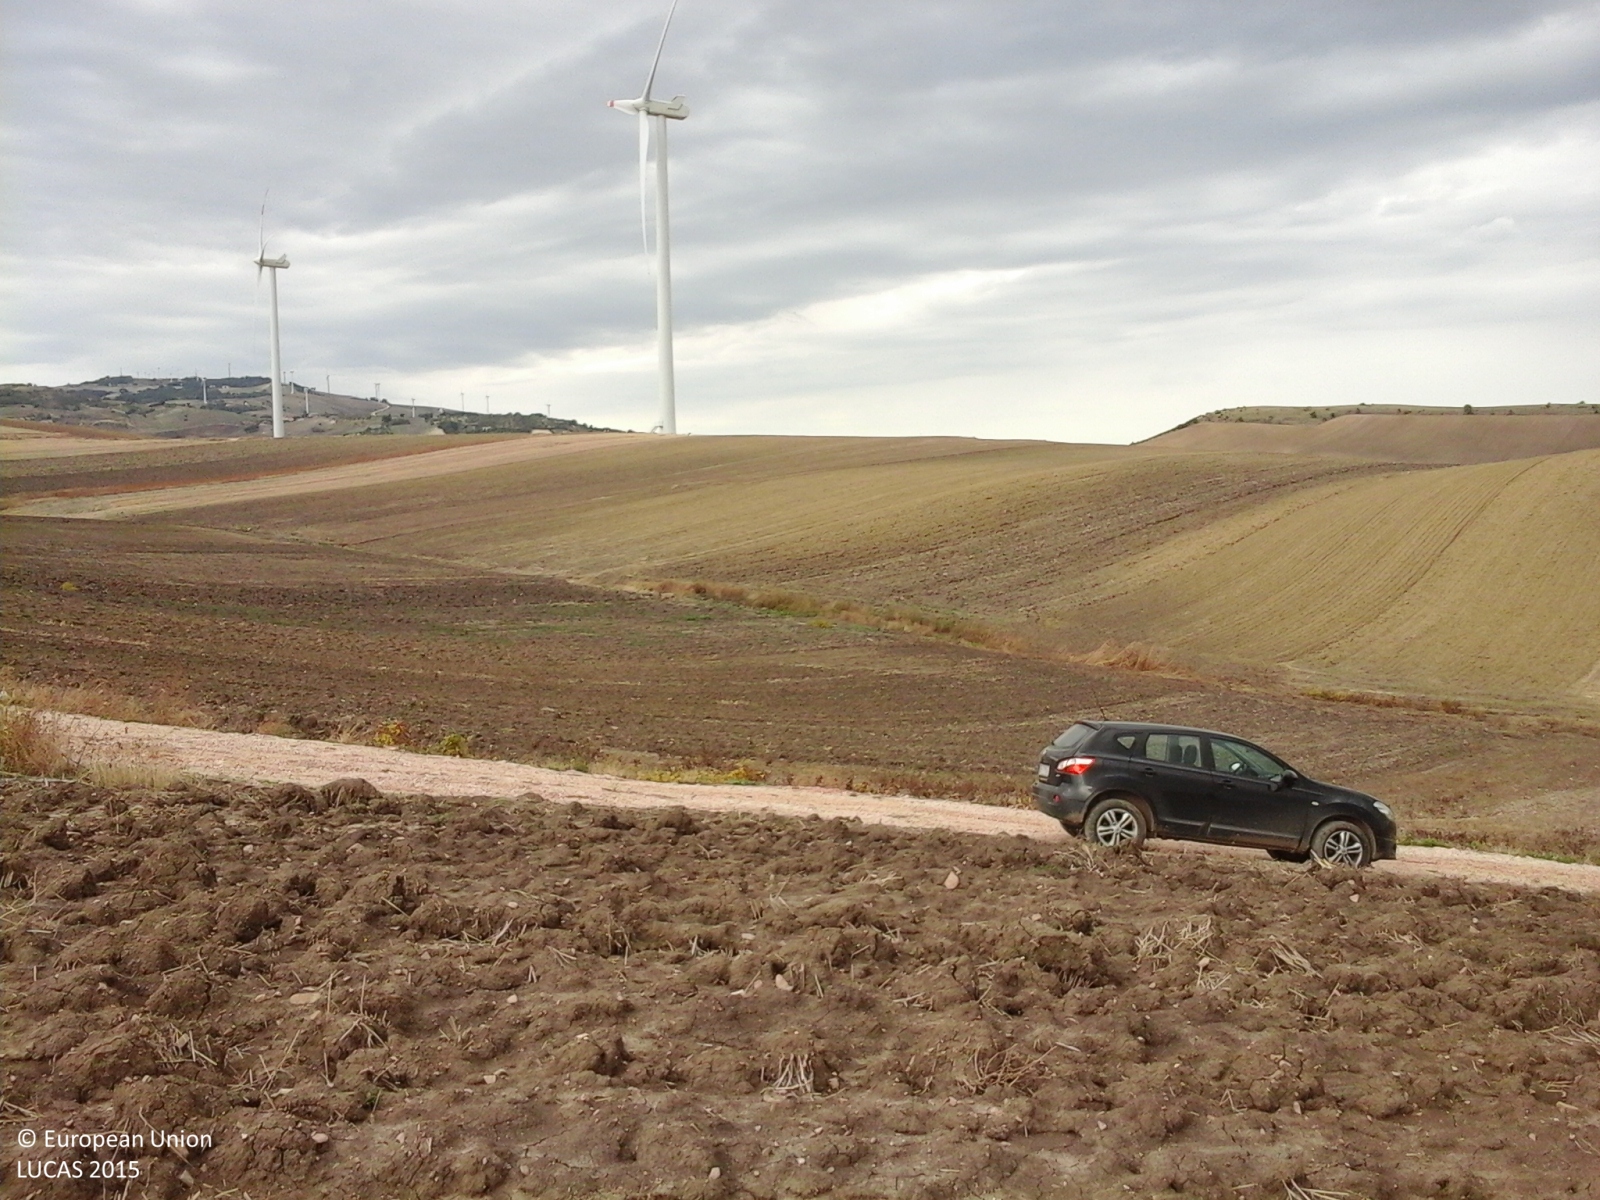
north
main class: Cropland
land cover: Durum wheat
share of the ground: > 75 %
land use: Agriculture (excluding fallow land and kitchen gardens)
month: October
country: IT
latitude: 41.5275
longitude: 15.1481
